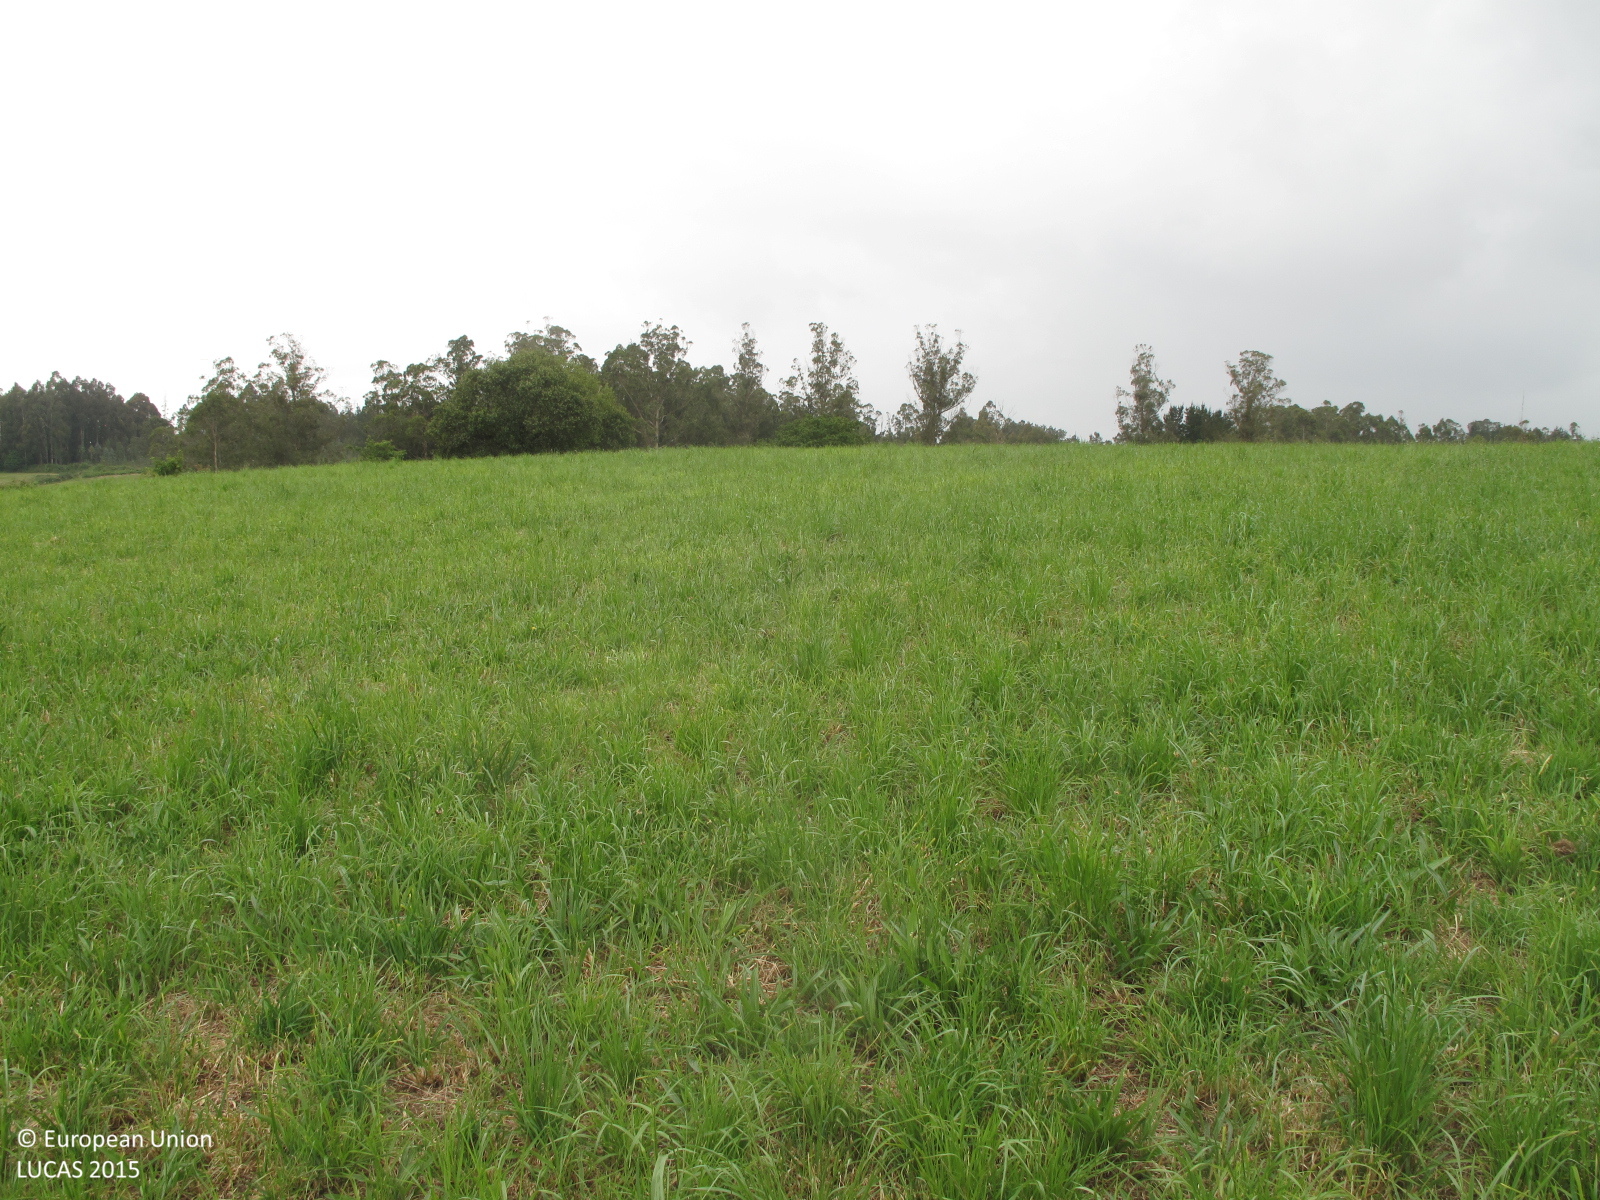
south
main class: Grassland
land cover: Grassland without tree/shrub cover
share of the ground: > 75 %
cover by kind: herbaceous plants 100 %
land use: Agriculture (excluding fallow land and kitchen gardens)
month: June
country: ES
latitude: 43.1508
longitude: -8.5921
